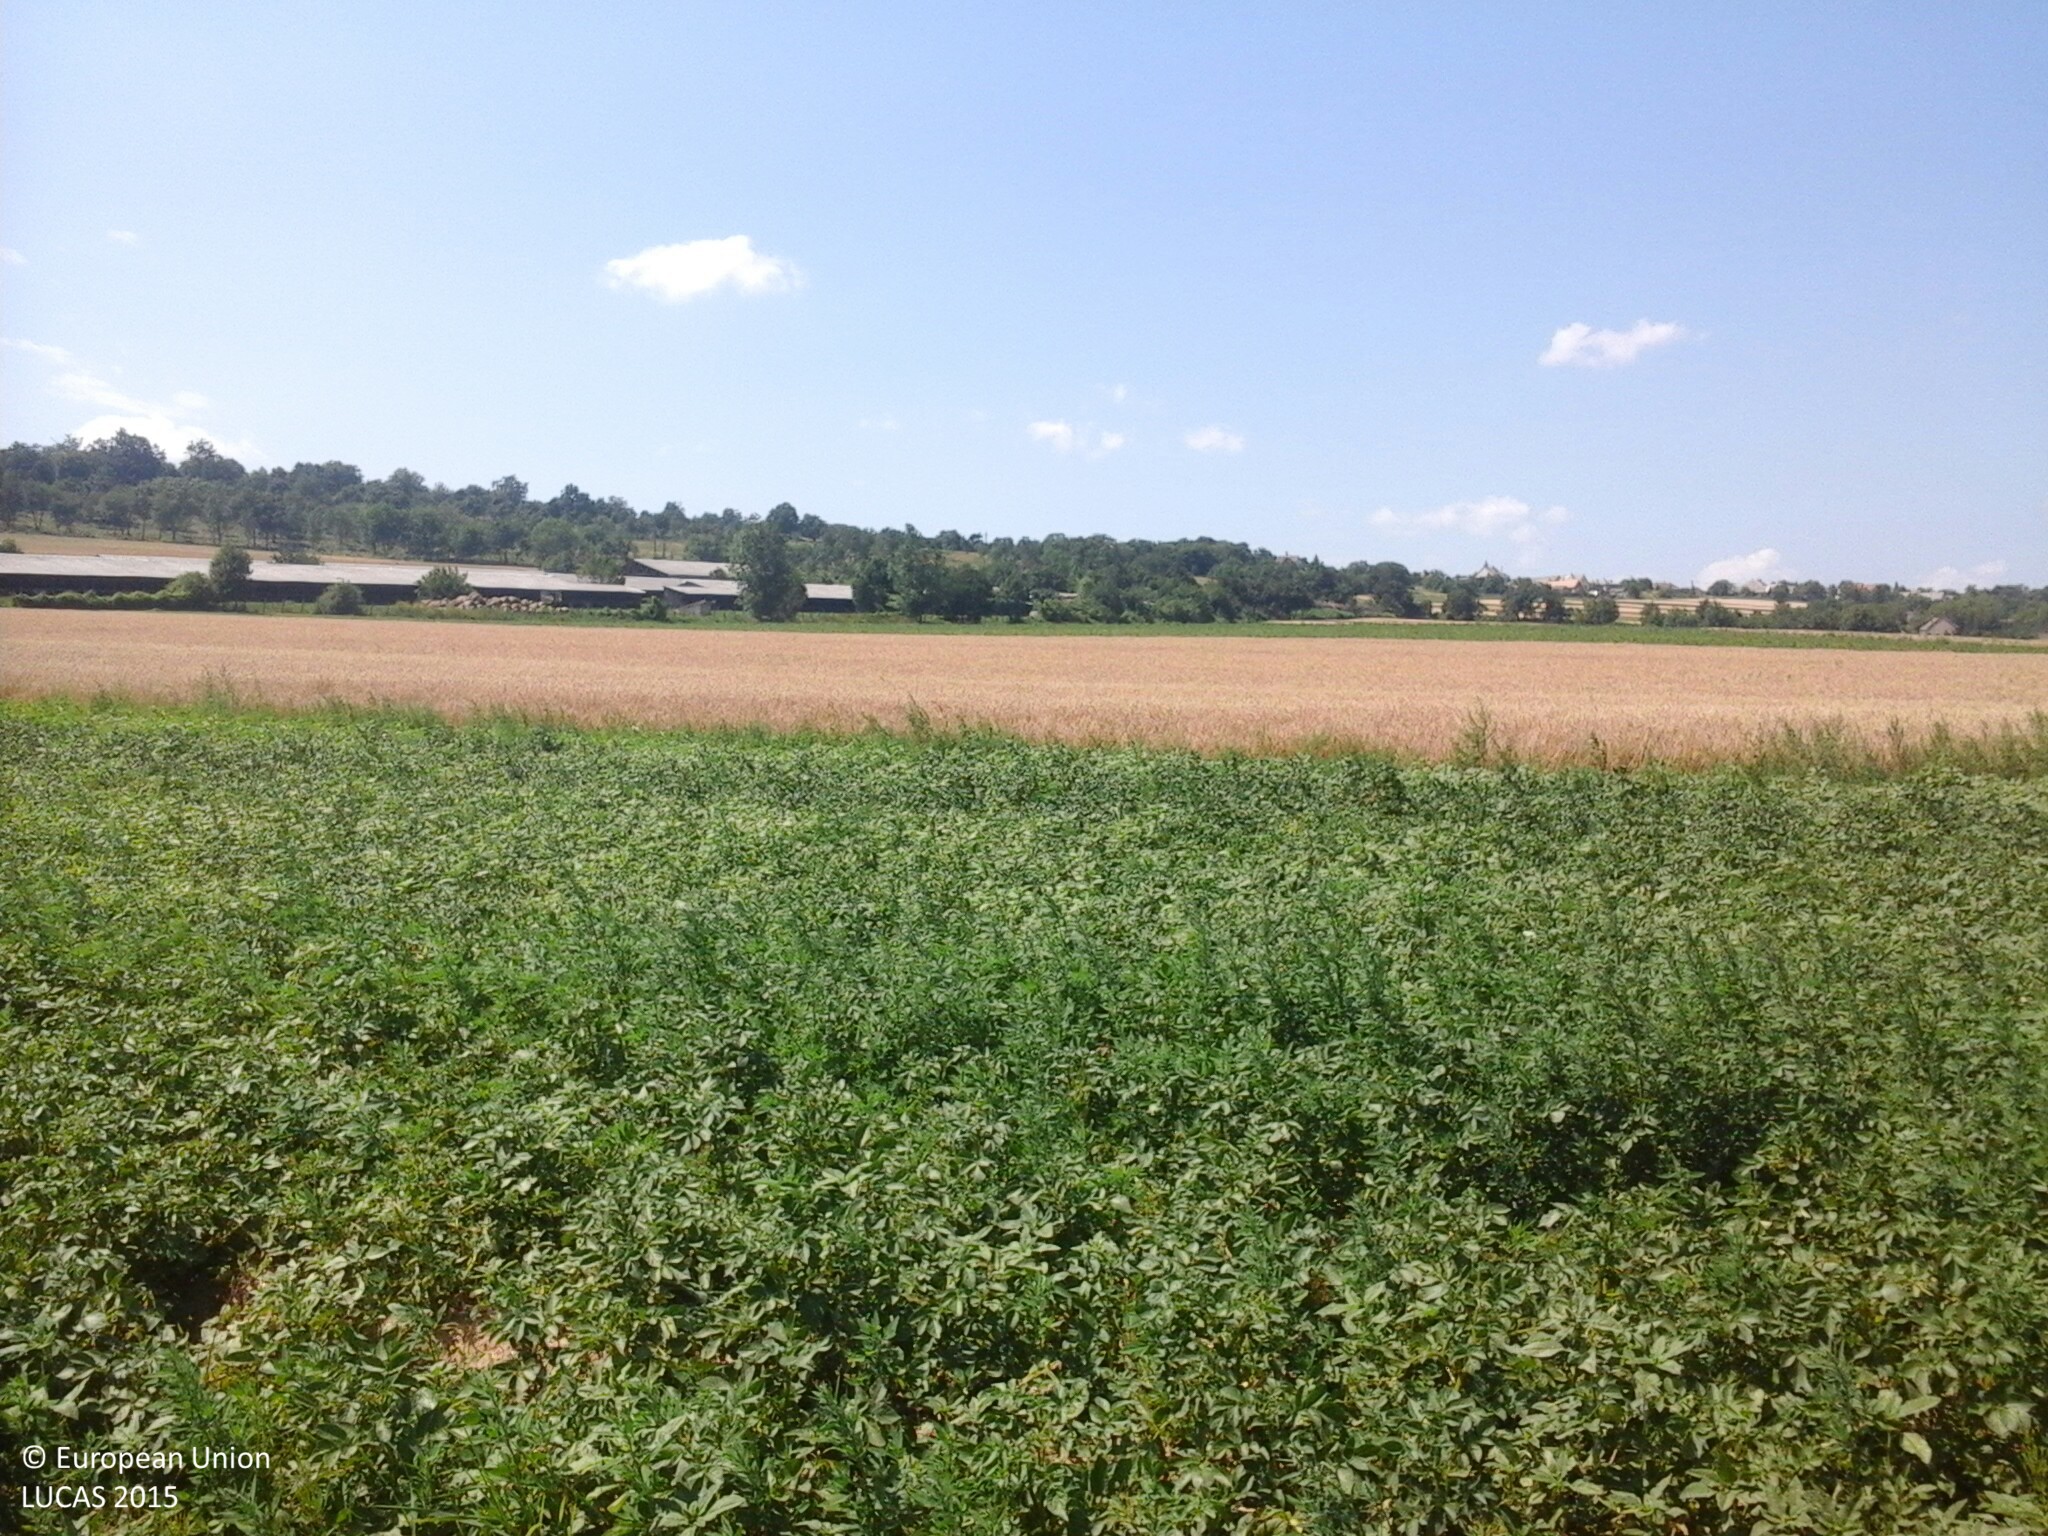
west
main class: Cropland
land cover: Potatoes
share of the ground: > 75 %
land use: Agriculture (excluding fallow land and kitchen gardens)
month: July
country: HU
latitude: 47.2330
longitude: 17.9214
